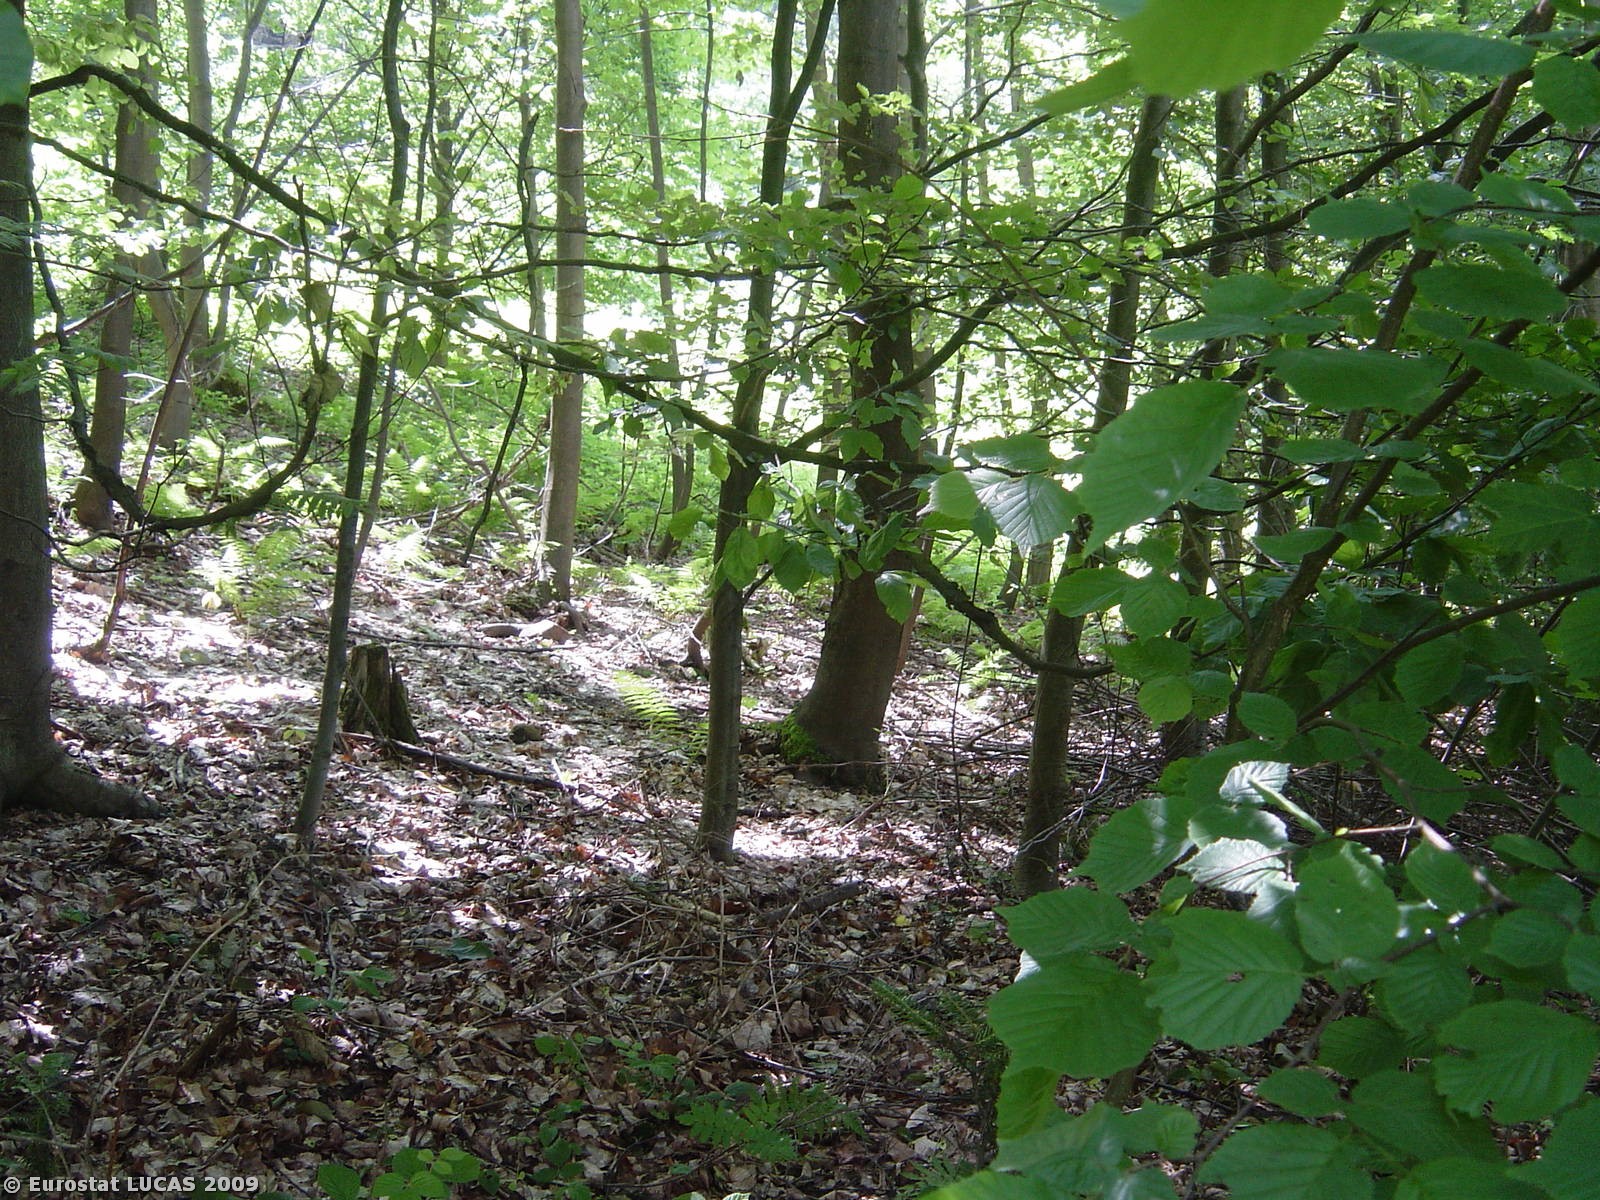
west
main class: Woodland
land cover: Mixed woodland
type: hemiboreal forest and nemoral coniferous forest and mixed broadleaved-coniferous forest
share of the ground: > 75 %
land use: Forestry
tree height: > 5 m
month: June
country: CZ
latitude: 49.8169
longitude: 16.5258
